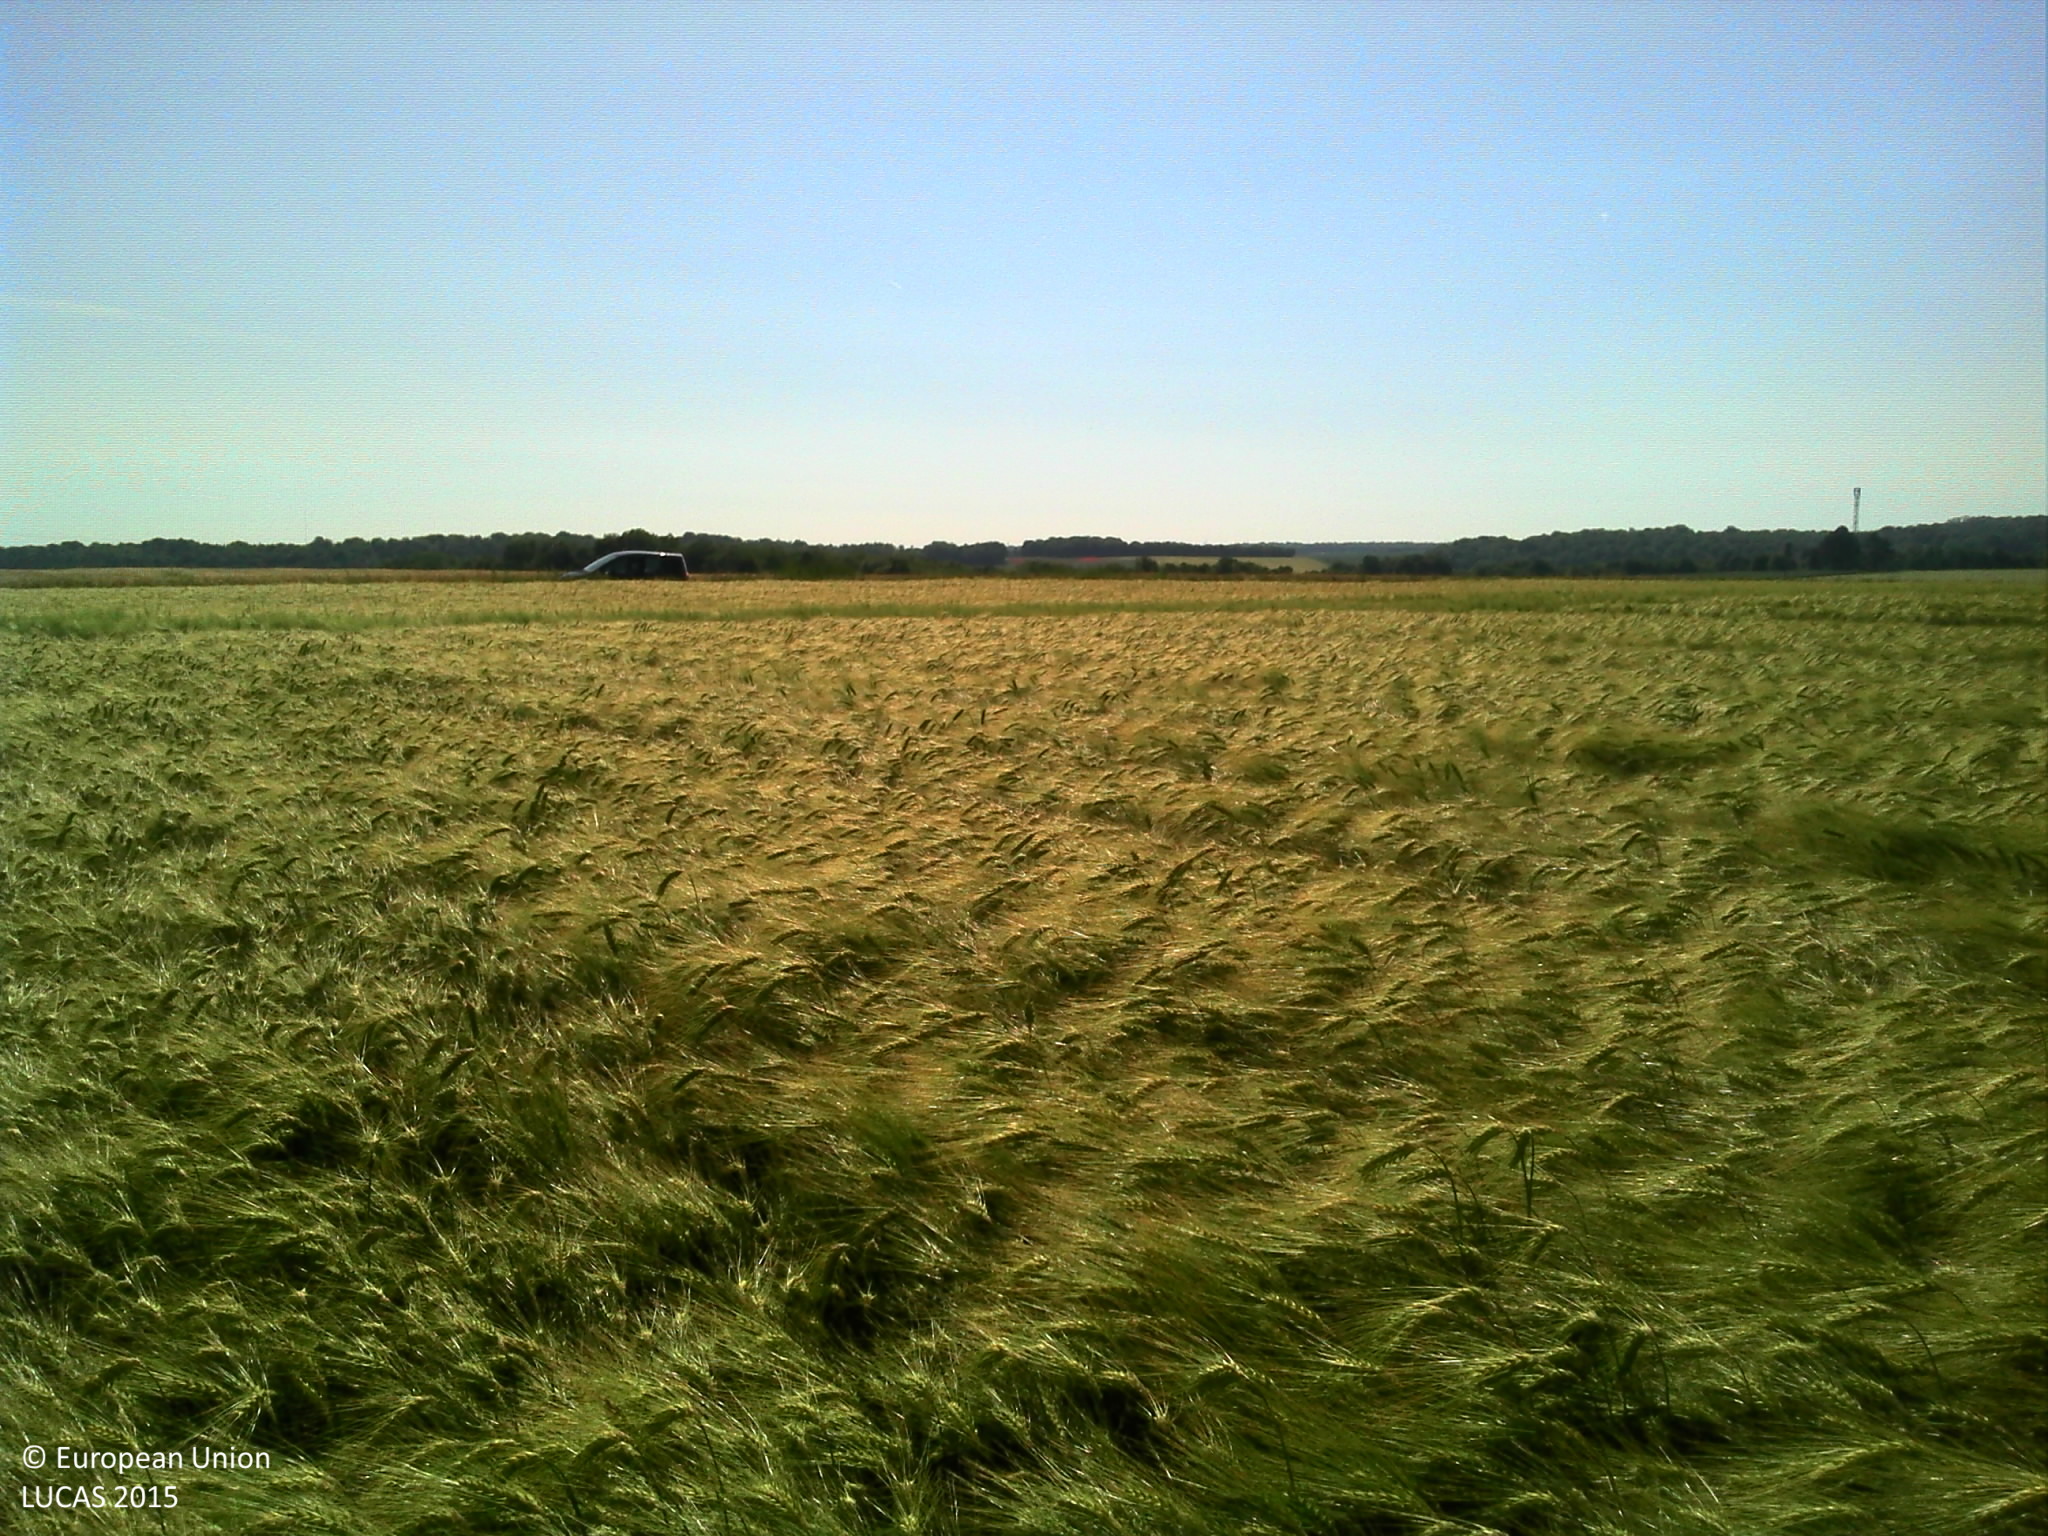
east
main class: Cropland
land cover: Barley
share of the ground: > 75 %
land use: Agriculture (excluding fallow land and kitchen gardens)
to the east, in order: Barley; Grass margins; Tracks; Grass margins; Barley
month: June
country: FR
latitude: 48.3764
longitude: 4.9085
